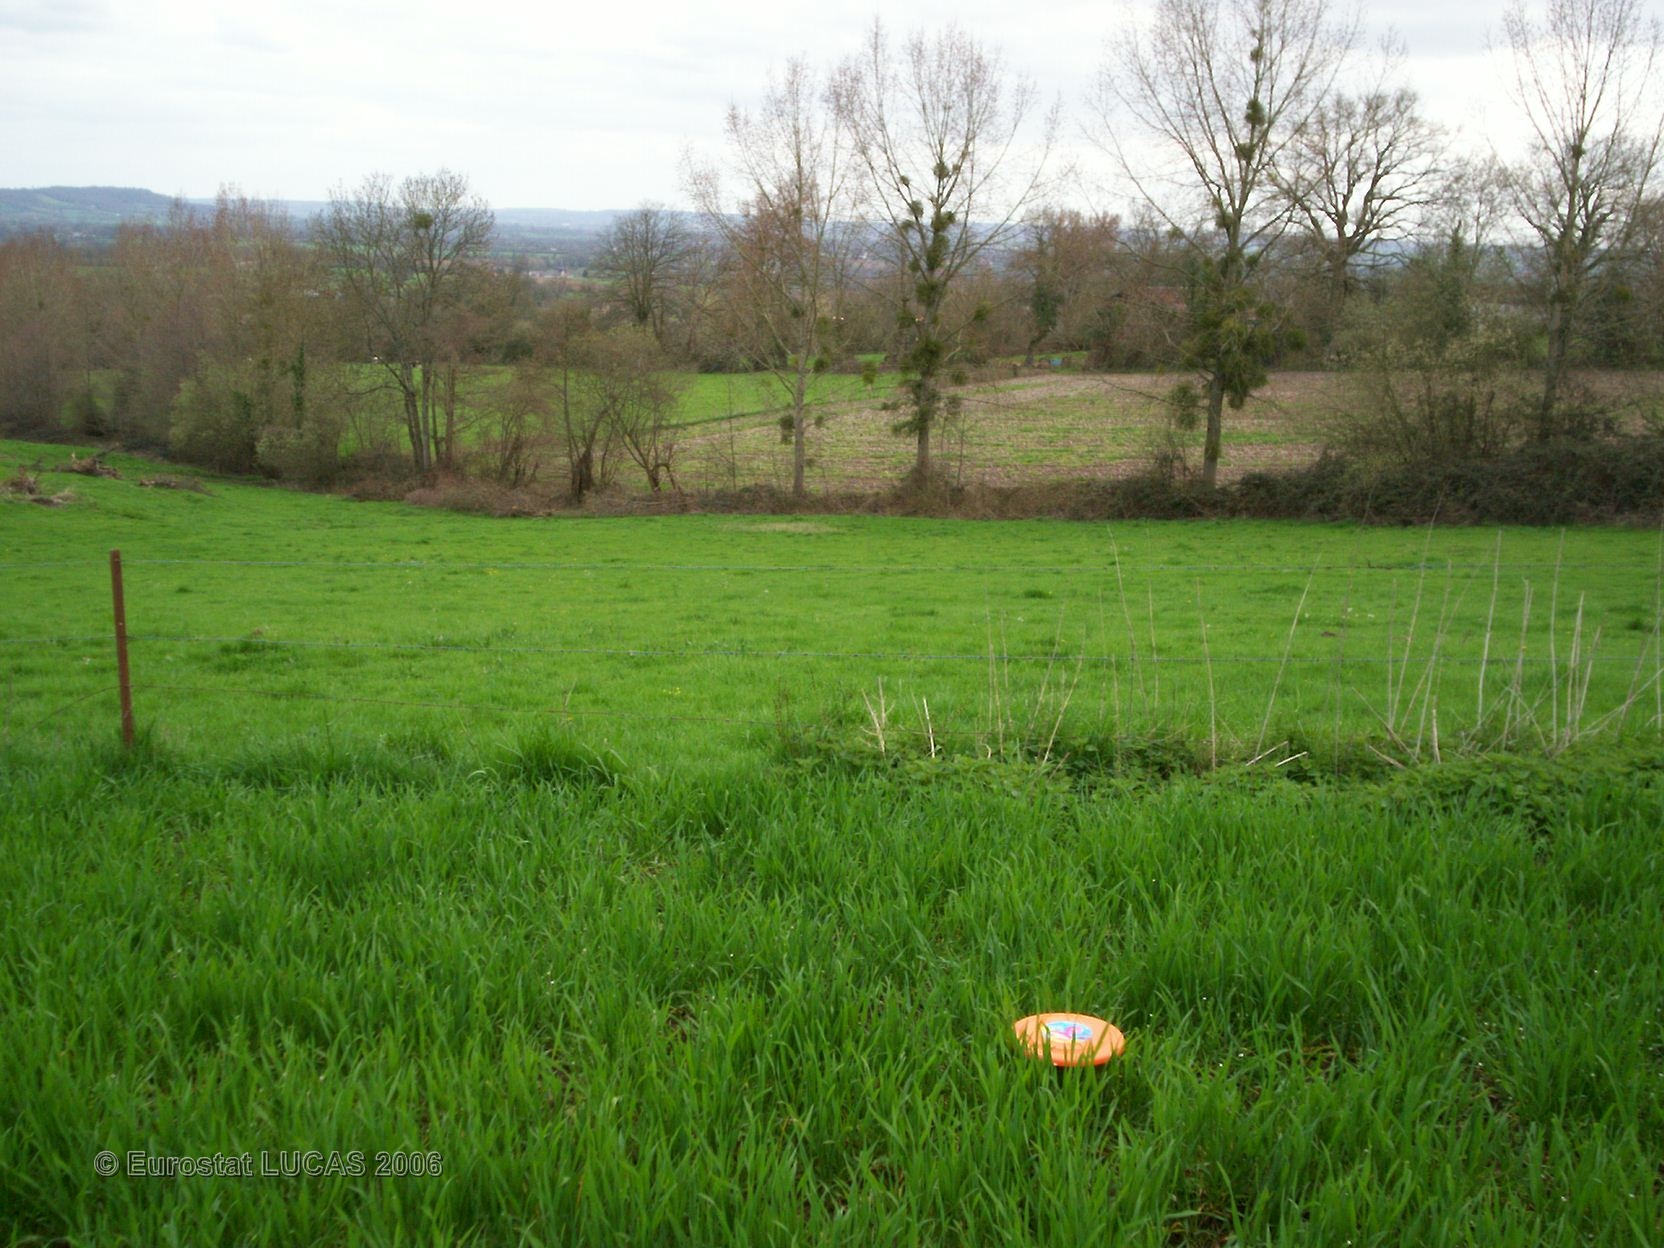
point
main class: Cropland
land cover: Common wheat
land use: Agriculture (excluding fallow land and kitchen gardens)
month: April
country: FR
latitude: 48.8811
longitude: 0.0840
